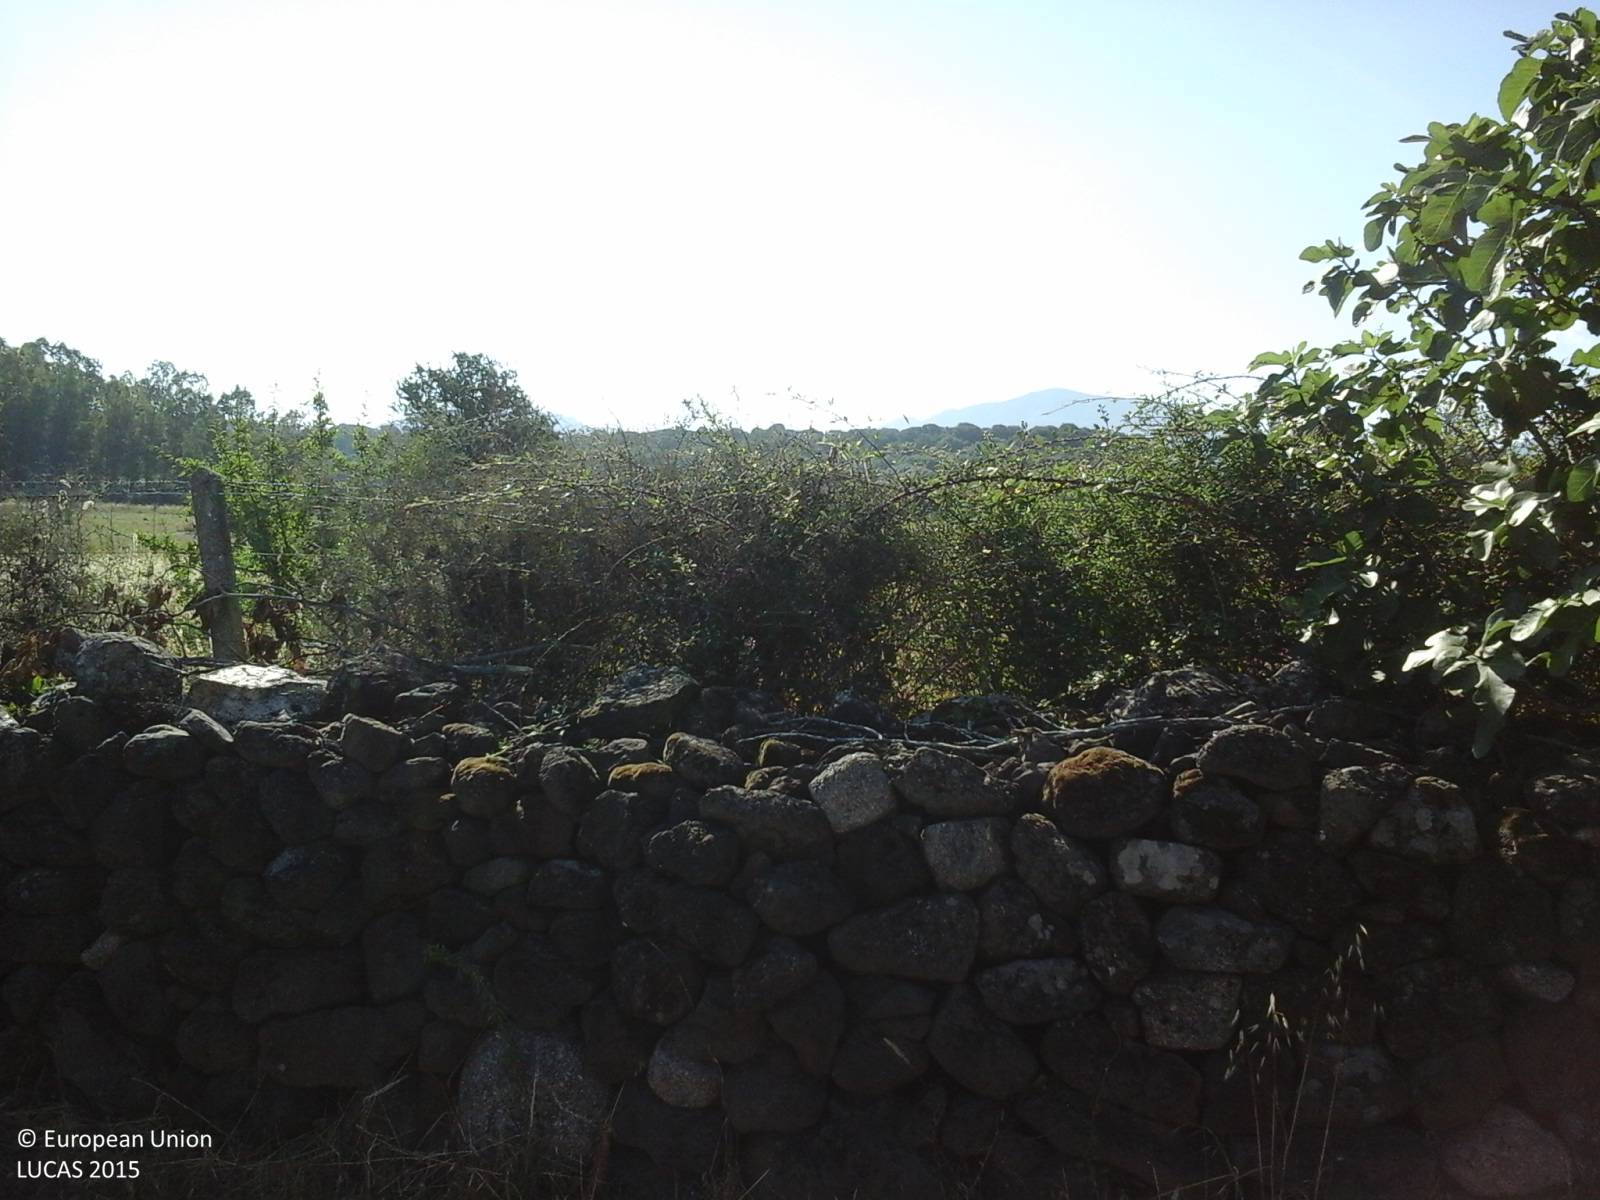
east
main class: Cropland
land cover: Vineyards
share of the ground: > 75 %
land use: Agriculture (excluding fallow land and kitchen gardens)
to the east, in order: Vineyards; Fences; Tracks; Dry stone walls; Grassland without tree/shrub cover; Dry stone walls; Grassland without tree/shrub cover
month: June
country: IT
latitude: 40.3205
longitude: 9.5200
